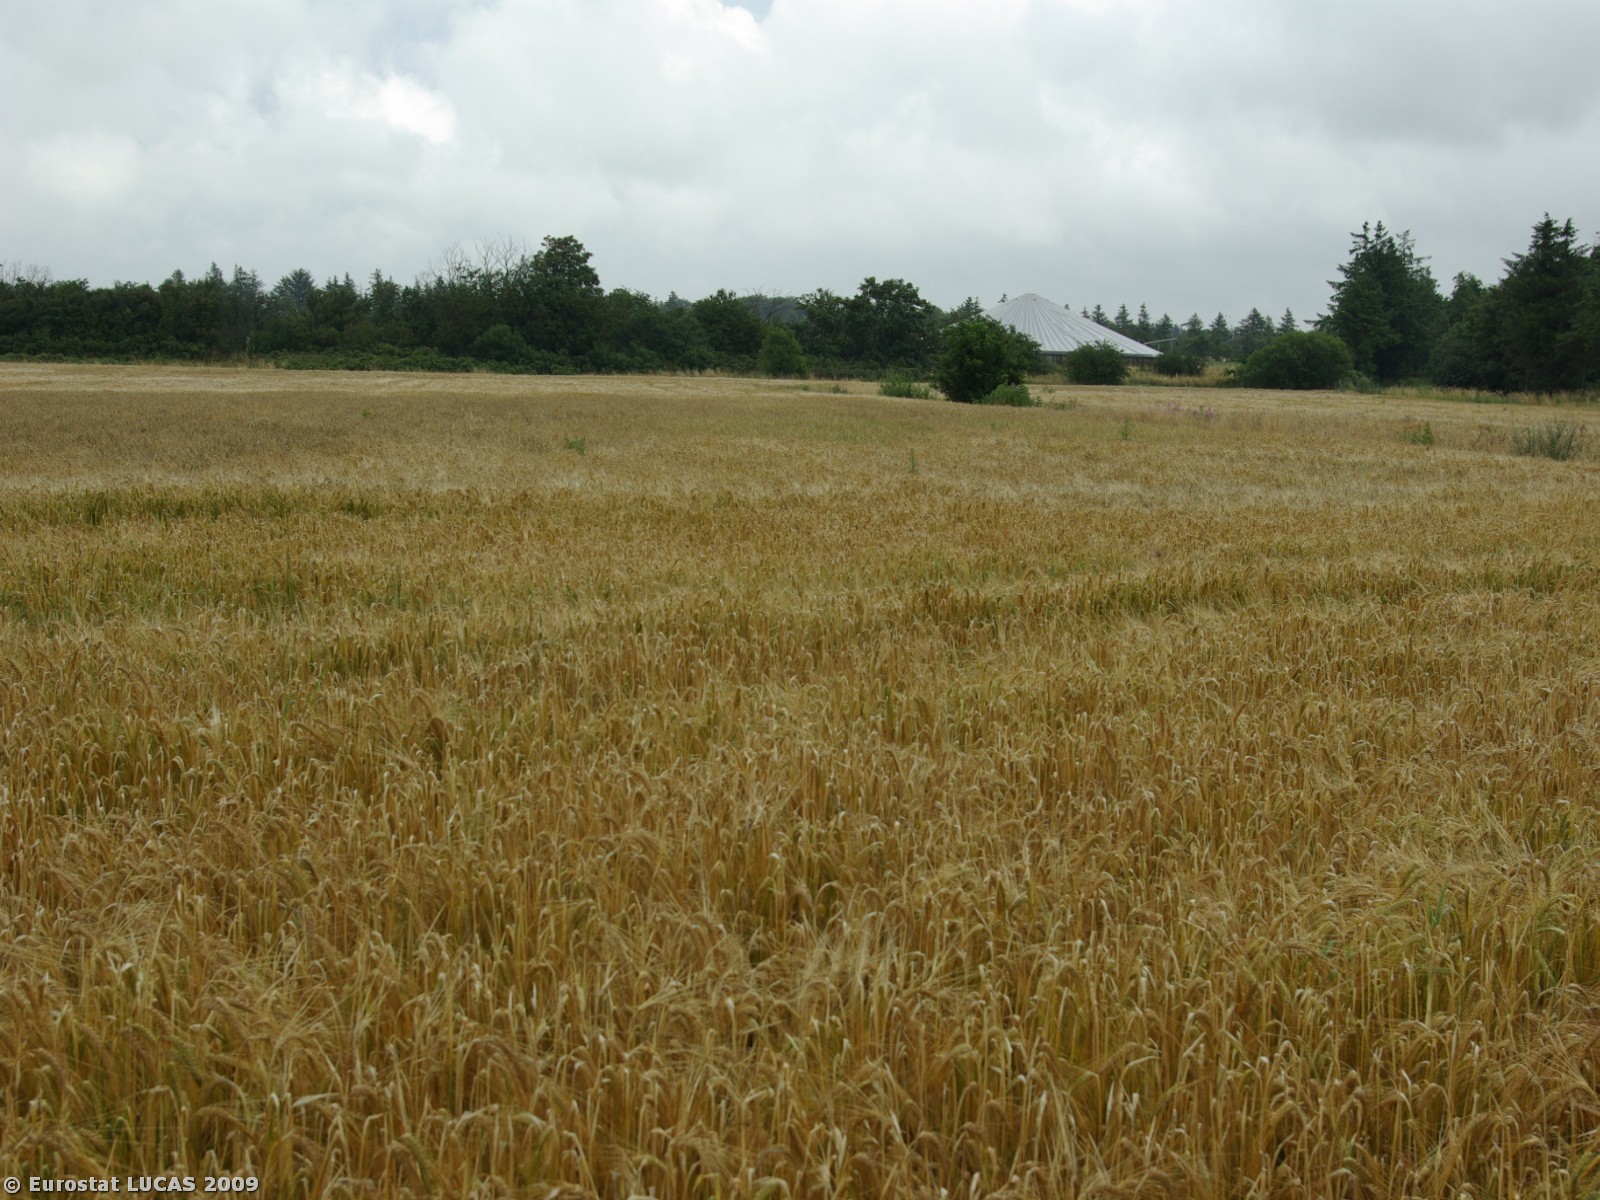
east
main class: Cropland
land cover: Barley
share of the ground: > 75 %
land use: Agriculture (excluding fallow land and kitchen gardens)
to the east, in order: Barley; Spontaneously vegetated surfaces; Rivers and streams; Spontaneously vegetated surfaces; Tracks; Broadleaved woodland; Spontaneously vegetated surfaces; Maize
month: July
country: DK
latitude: 55.2835
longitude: 8.8202
